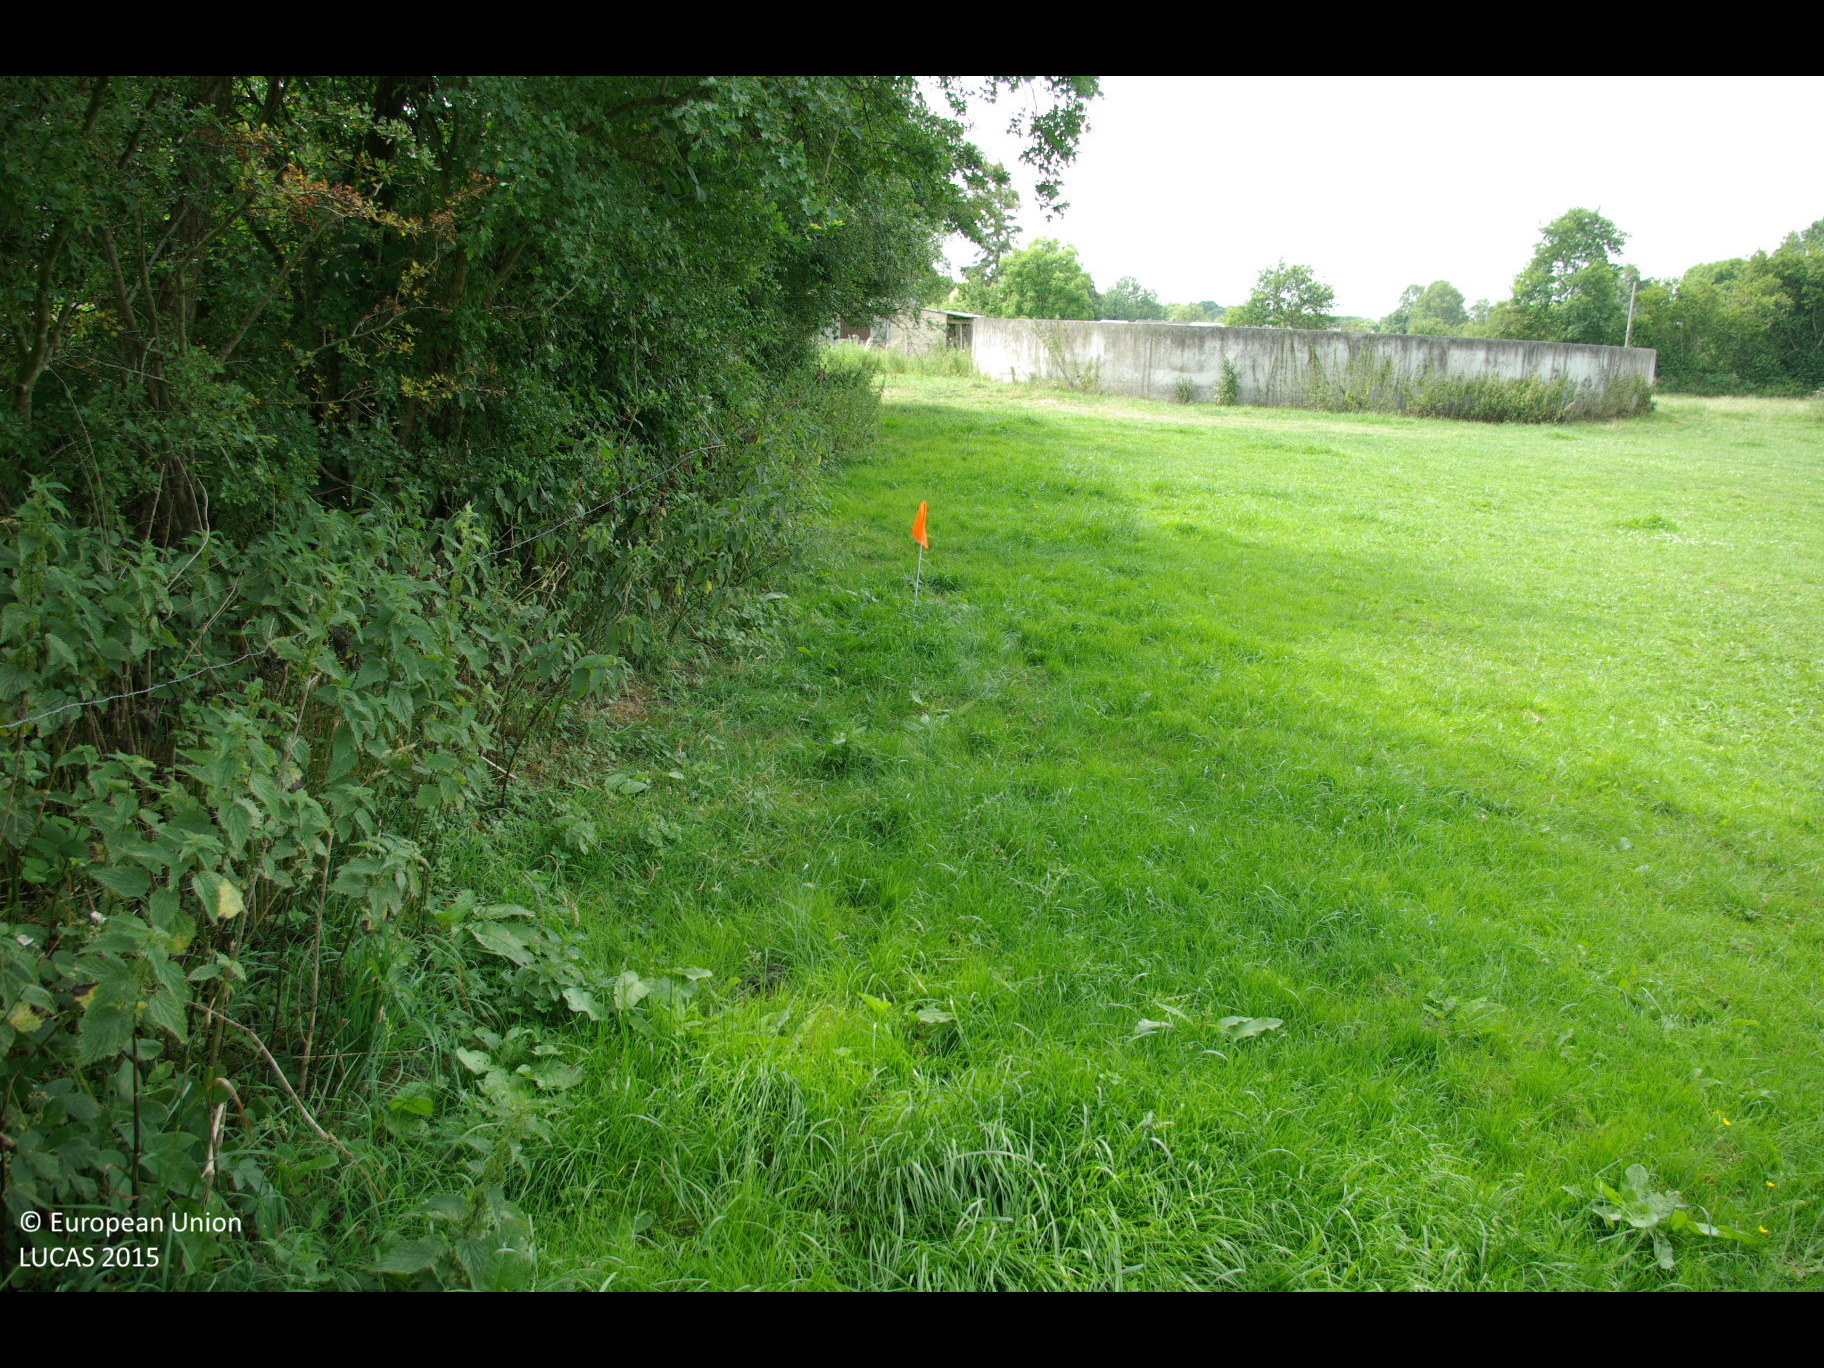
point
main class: Grassland
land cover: Grassland without tree/shrub cover
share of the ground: > 75 %
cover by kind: herbaceous plants 100 %
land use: Agriculture (excluding fallow land and kitchen gardens)
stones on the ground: < 10 %
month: July
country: DE
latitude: 54.2627
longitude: 9.3096
